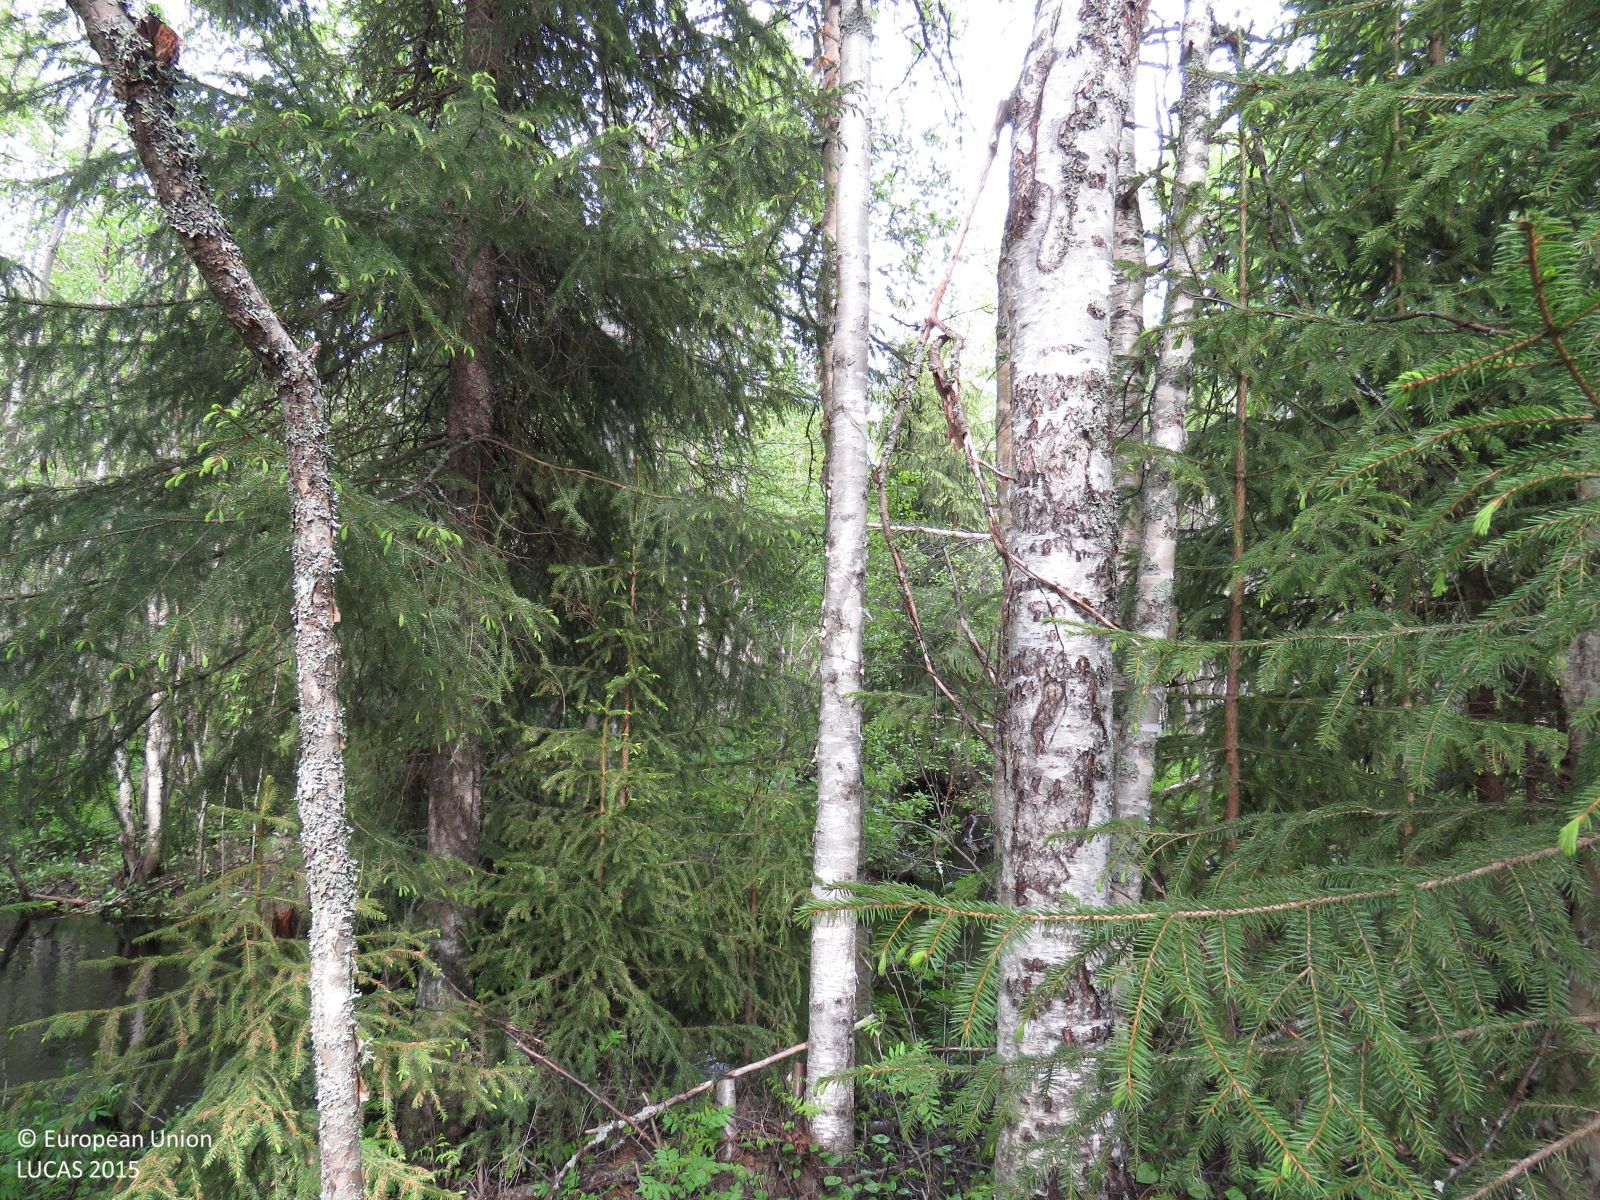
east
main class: Woodland
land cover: Other mixed woodland
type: boreal forest
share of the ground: > 75 %
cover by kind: broadleaved forest trees 50 %, coniferous forest trees 25 %, herbaceous plants 10 %, shrubs 5 %
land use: Semi-natural and natural areas not in use
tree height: > 5 m
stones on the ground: < 10 %
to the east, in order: Other mixed woodland; Broadleaved woodland; Inland fresh running water; Pine dominated mixed woodland; Ditches and canals; Other mixed woodland; Spruce dominated mixed woodland; Inland fresh running water; Other mixed woodland; Tracks; Other mixed woodland
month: June
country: FI
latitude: 65.0361
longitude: 25.8697
